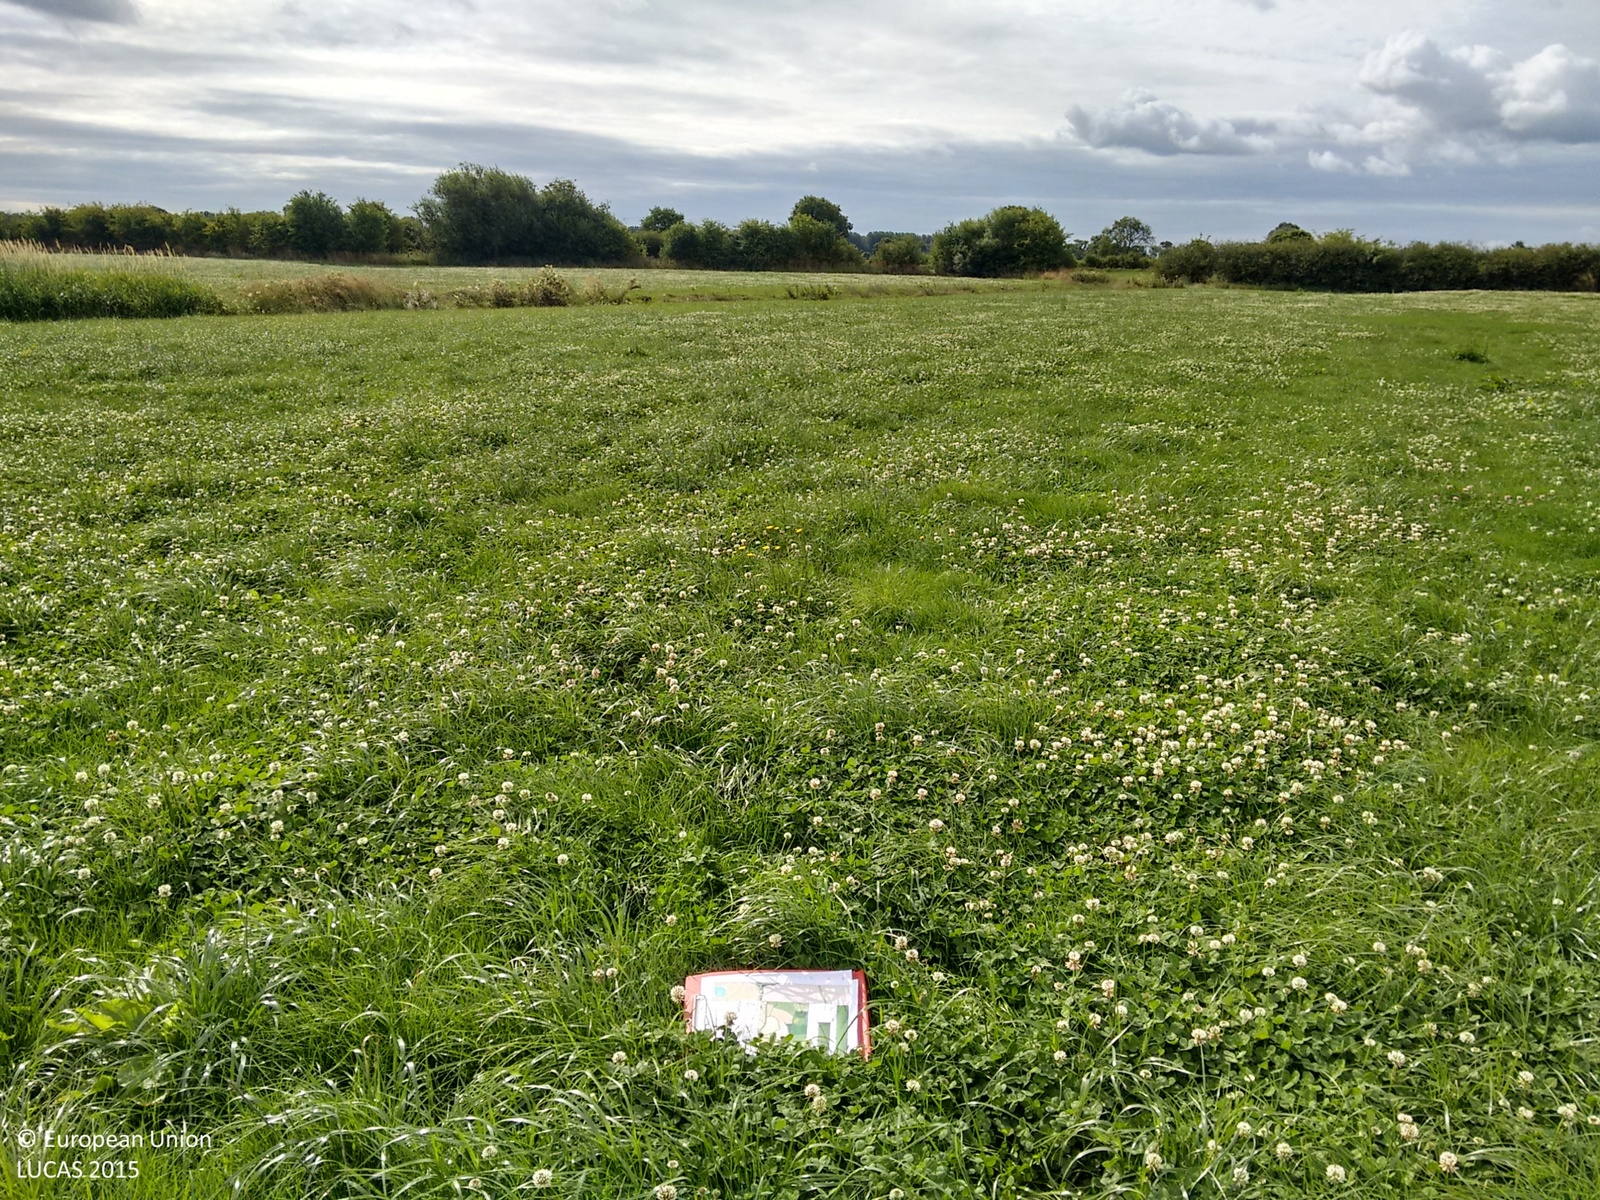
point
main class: Grassland
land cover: Grassland without tree/shrub cover
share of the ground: > 75 %
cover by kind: herbaceous plants 100 %
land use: Agriculture (excluding fallow land and kitchen gardens)
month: July
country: GB
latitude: 53.1085
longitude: -2.9047
